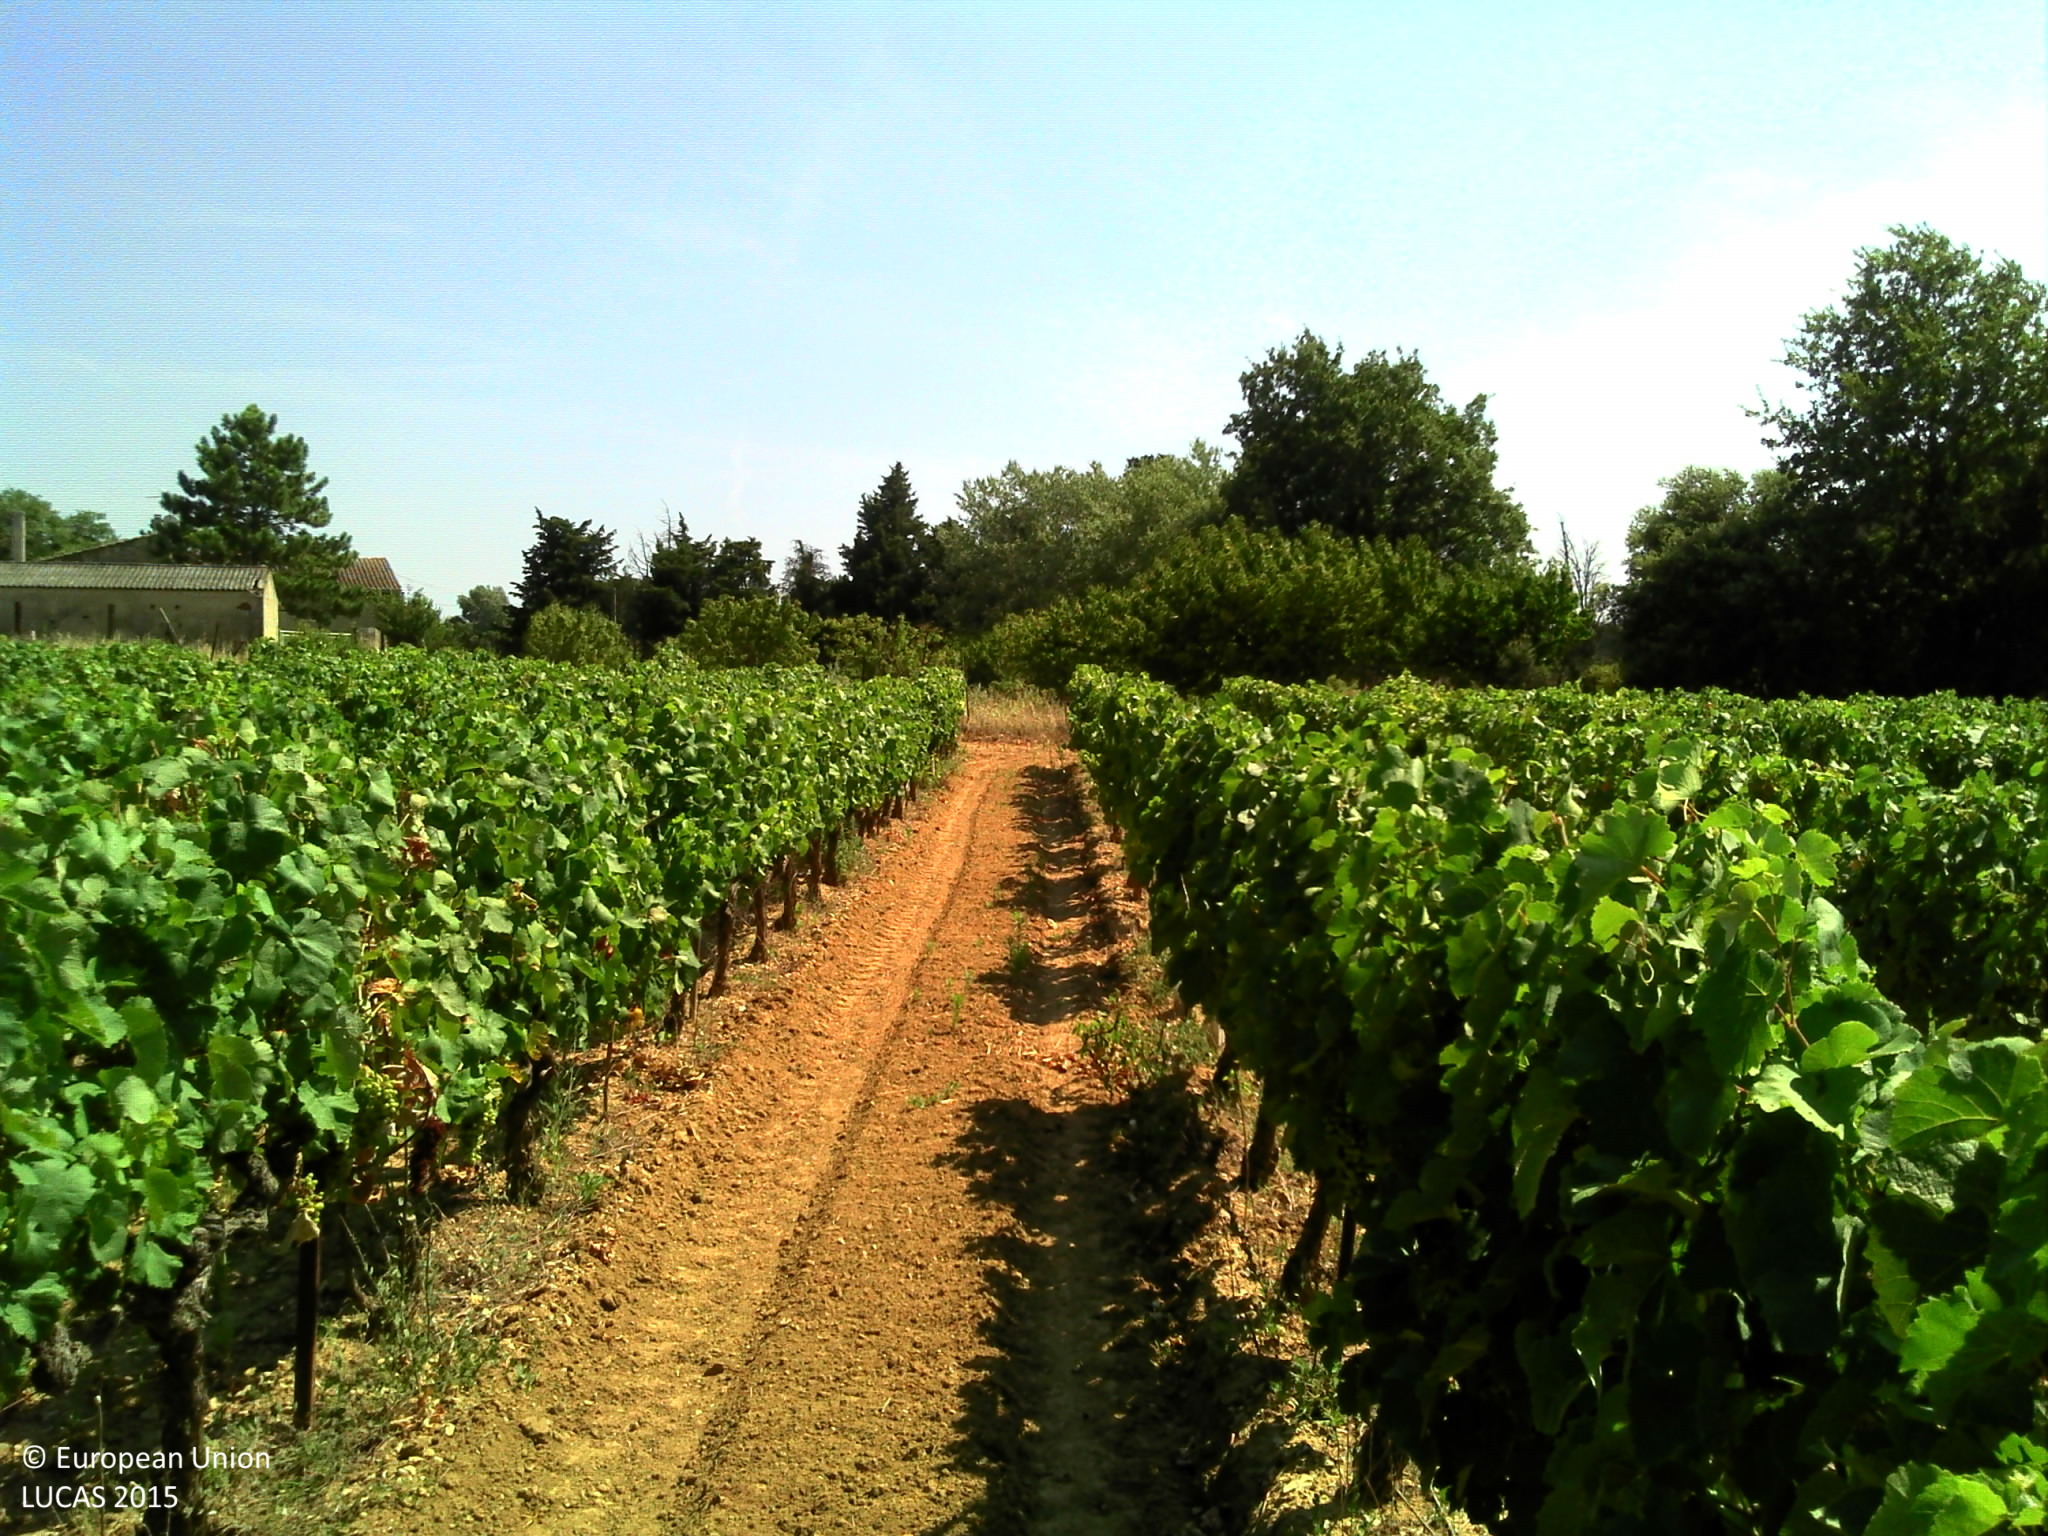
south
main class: Cropland
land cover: Vineyards
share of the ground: 25 - 50 %
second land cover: Other bare soil
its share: > 75 %
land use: Agriculture (excluding fallow land and kitchen gardens)
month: July
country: FR
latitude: 44.0879
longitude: 5.0499
